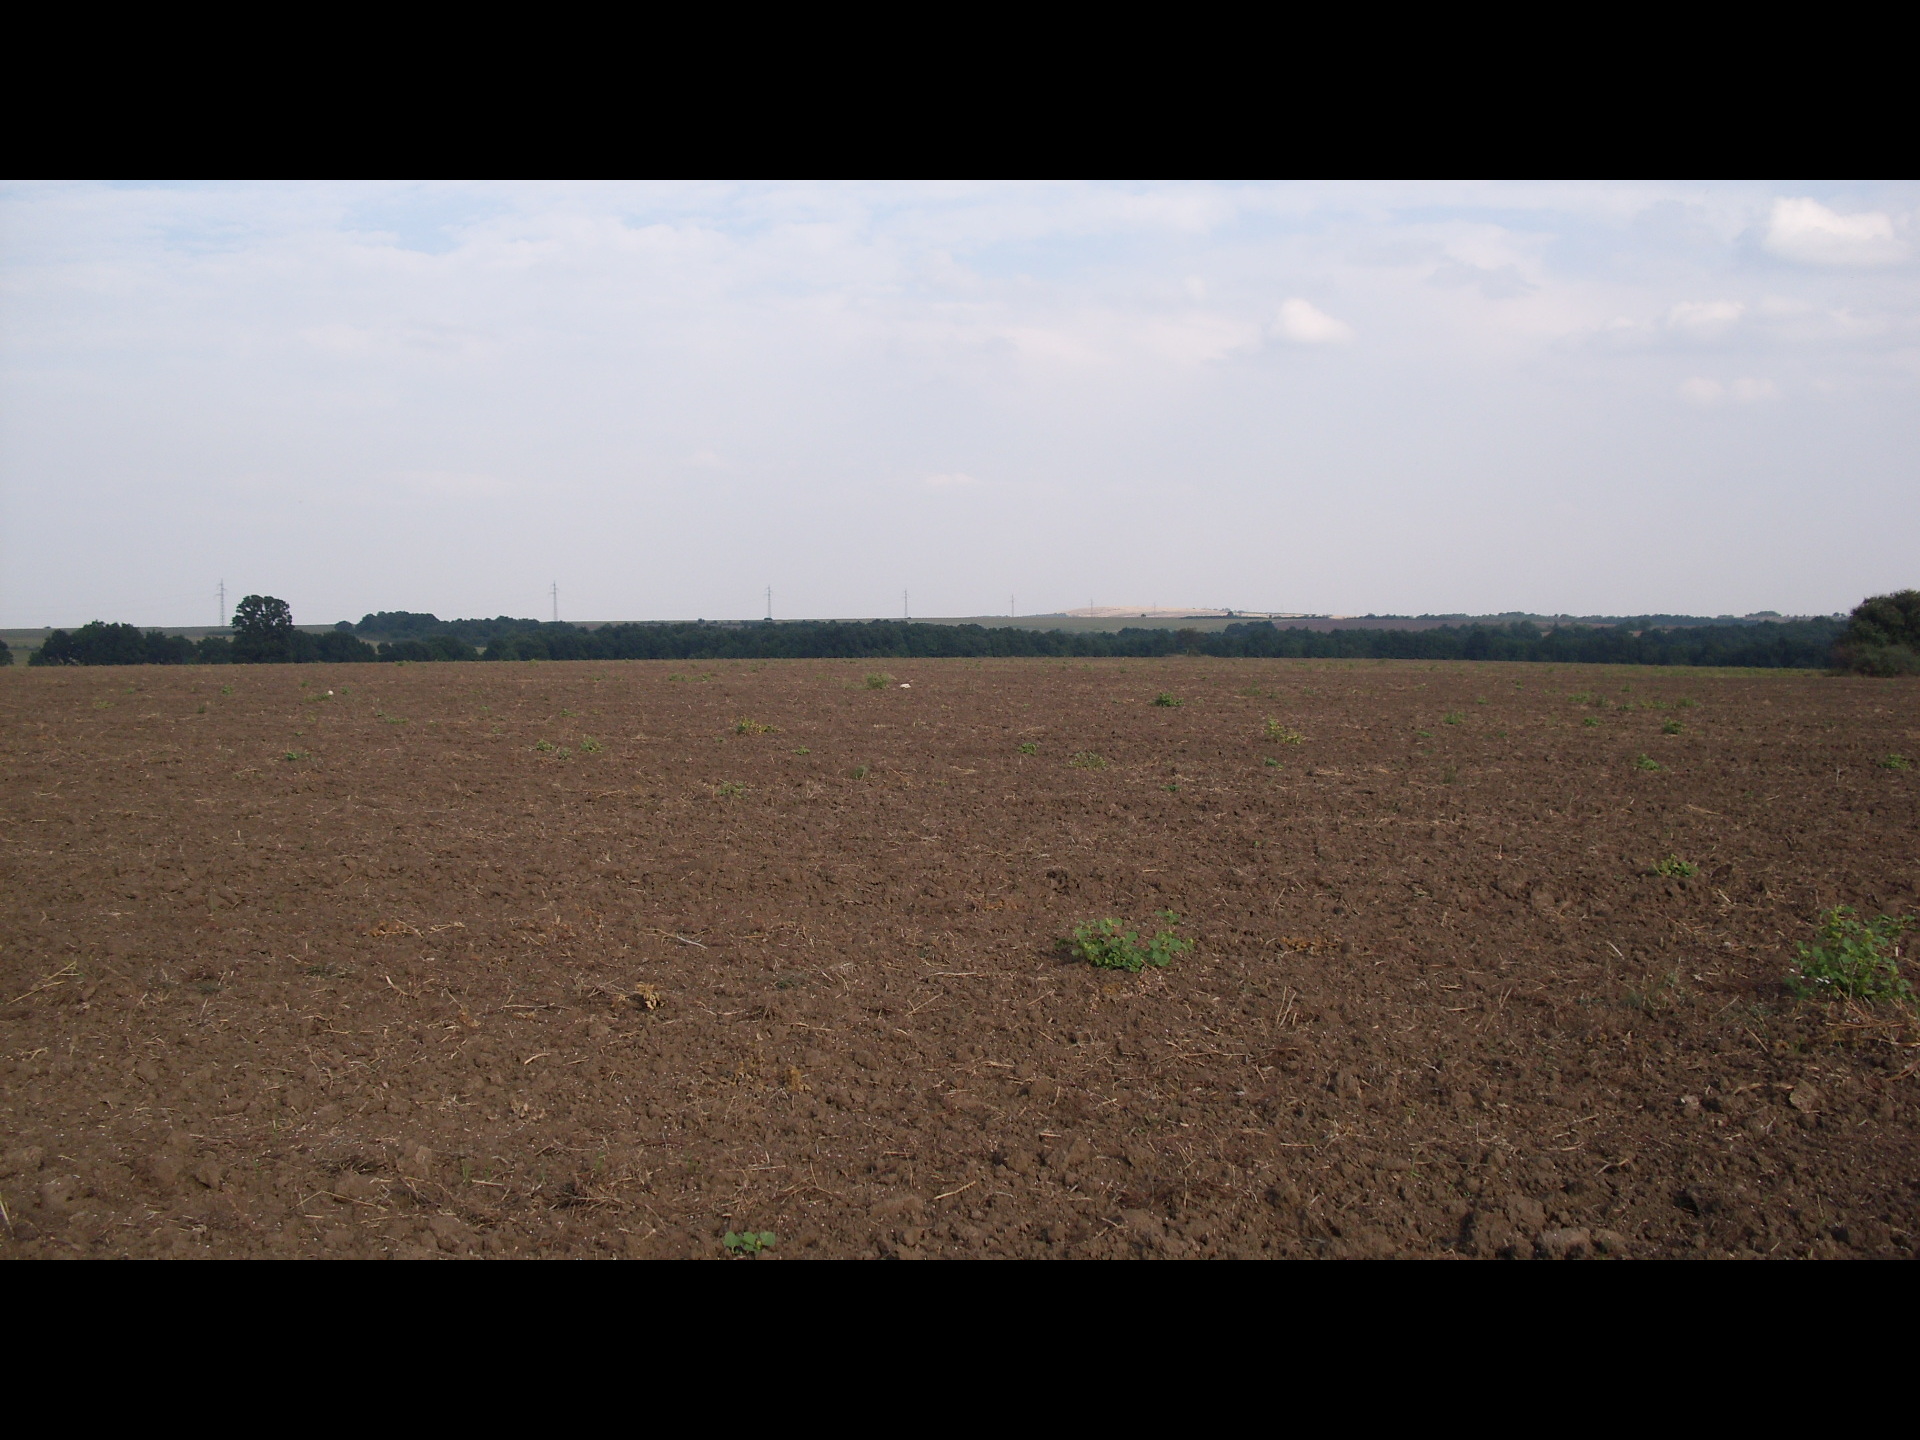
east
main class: Cropland
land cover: Rape and turnip rape
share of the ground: < 10 %
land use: Agriculture (excluding fallow land and kitchen gardens)
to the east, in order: Rape and turnip rape
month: September
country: BG
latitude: 43.4583
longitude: 23.4028
